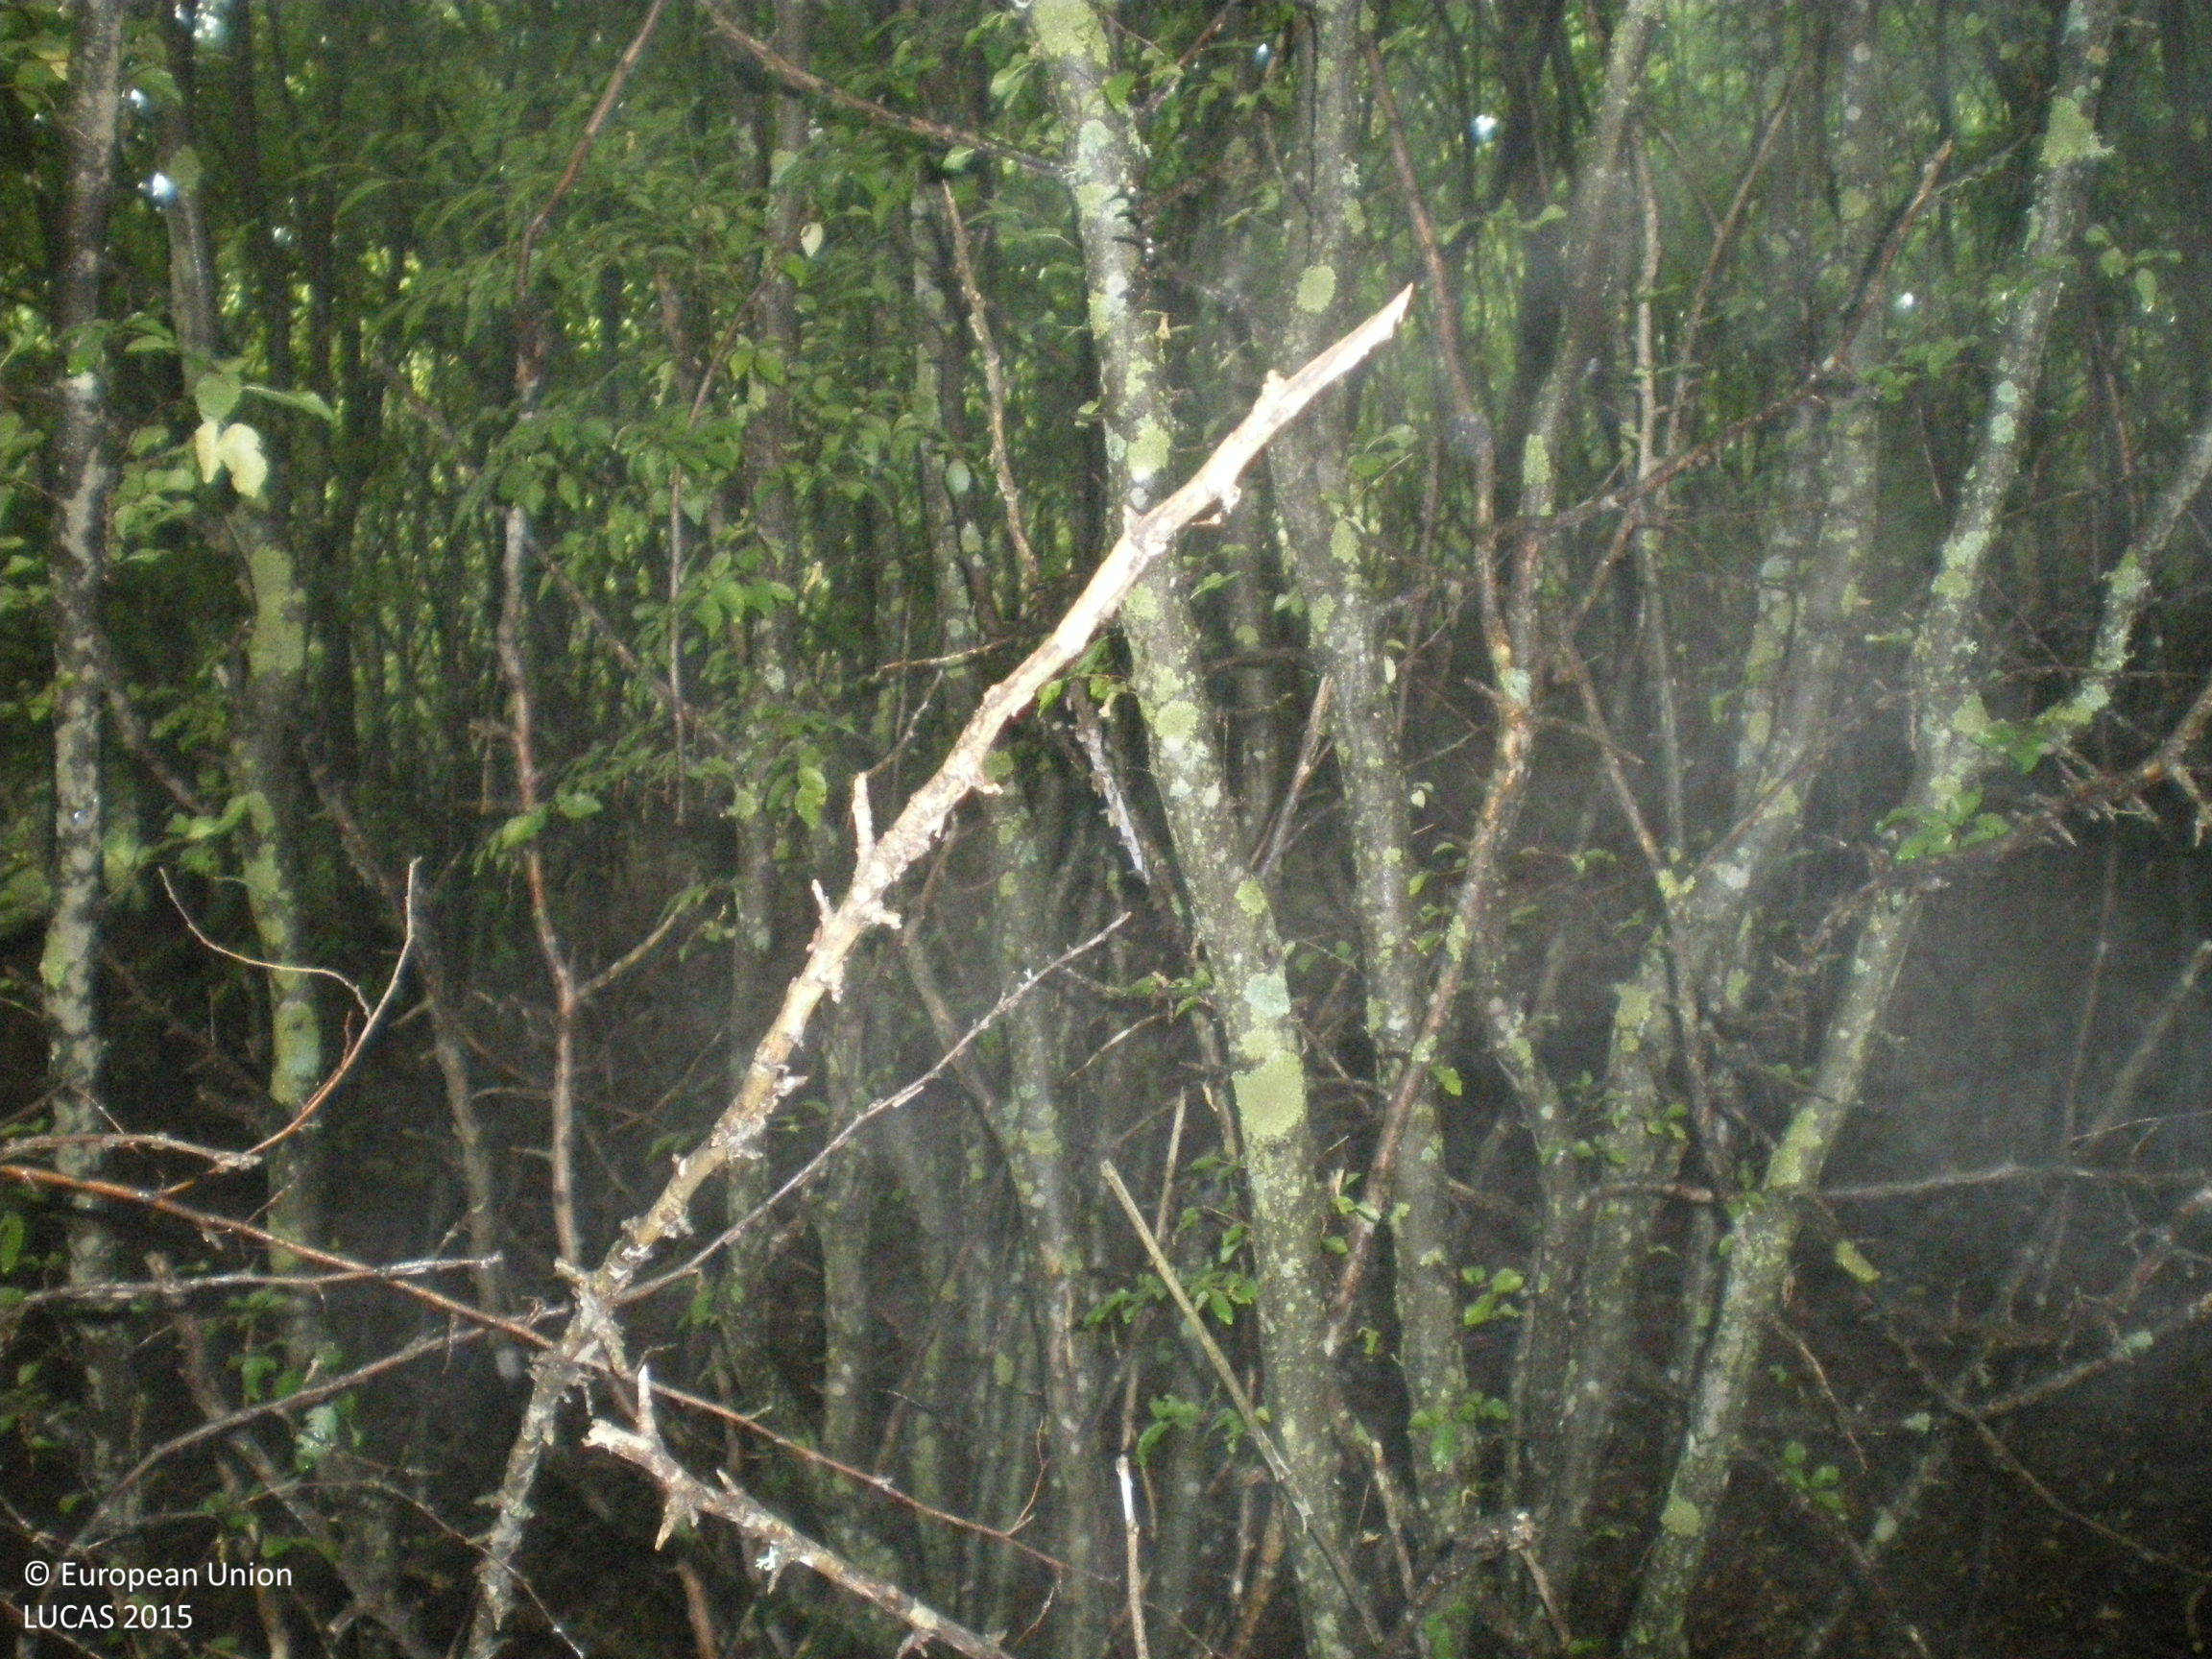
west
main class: Woodland
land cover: Broadleaved woodland
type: mesophytic deciduous forest
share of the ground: > 75 %
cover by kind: broadleaved forest trees 95 %, unconsolidated bare surface 5 %
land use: Forestry
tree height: > 5 m
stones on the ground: < 10 %
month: July
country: BG
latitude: 42.4241
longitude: 25.2690
